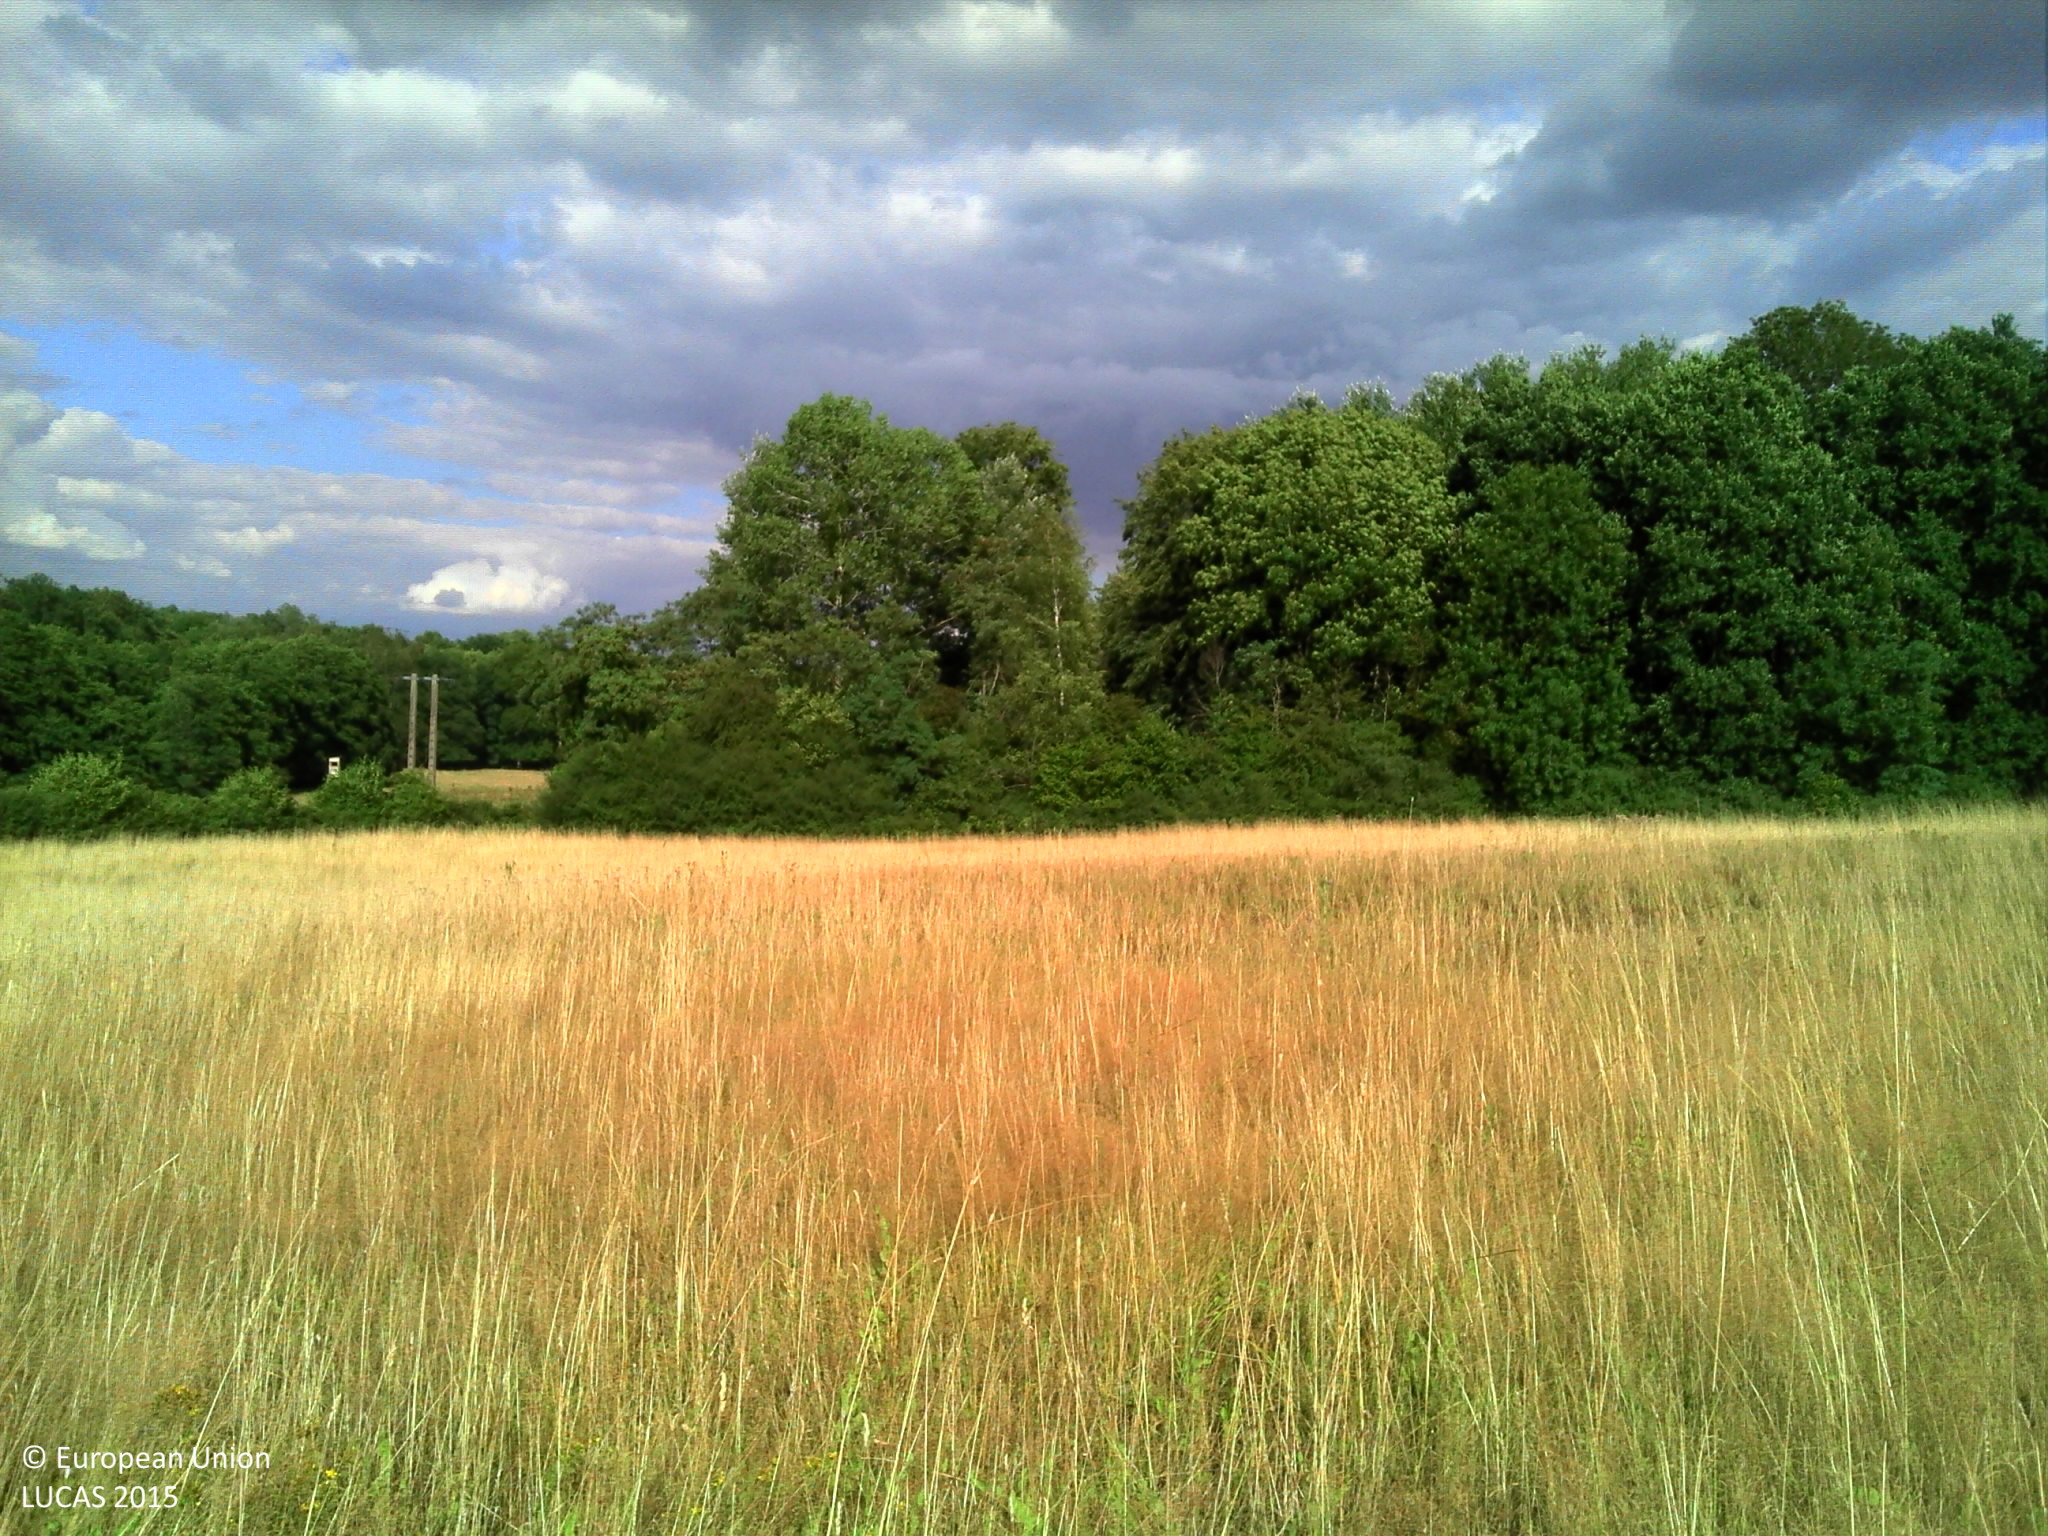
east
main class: Grassland
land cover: Grassland without tree/shrub cover
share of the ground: > 75 %
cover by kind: herbaceous plants 90 %, lichens and mosses 5 %, unconsolidated bare surface 5 %
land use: Agriculture (excluding fallow land and kitchen gardens)
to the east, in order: Grassland without tree/shrub cover; Broadleaved woodland; Ditches and canals; Grass margins; Paved roads, cycling and walking lanes; Grass margins; Fences; Single bushes/trees; Grassland without tree/shrub cover; Electric lines; Grassland without tree/shrub cover
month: July
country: FR
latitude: 48.9487
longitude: 3.7541
